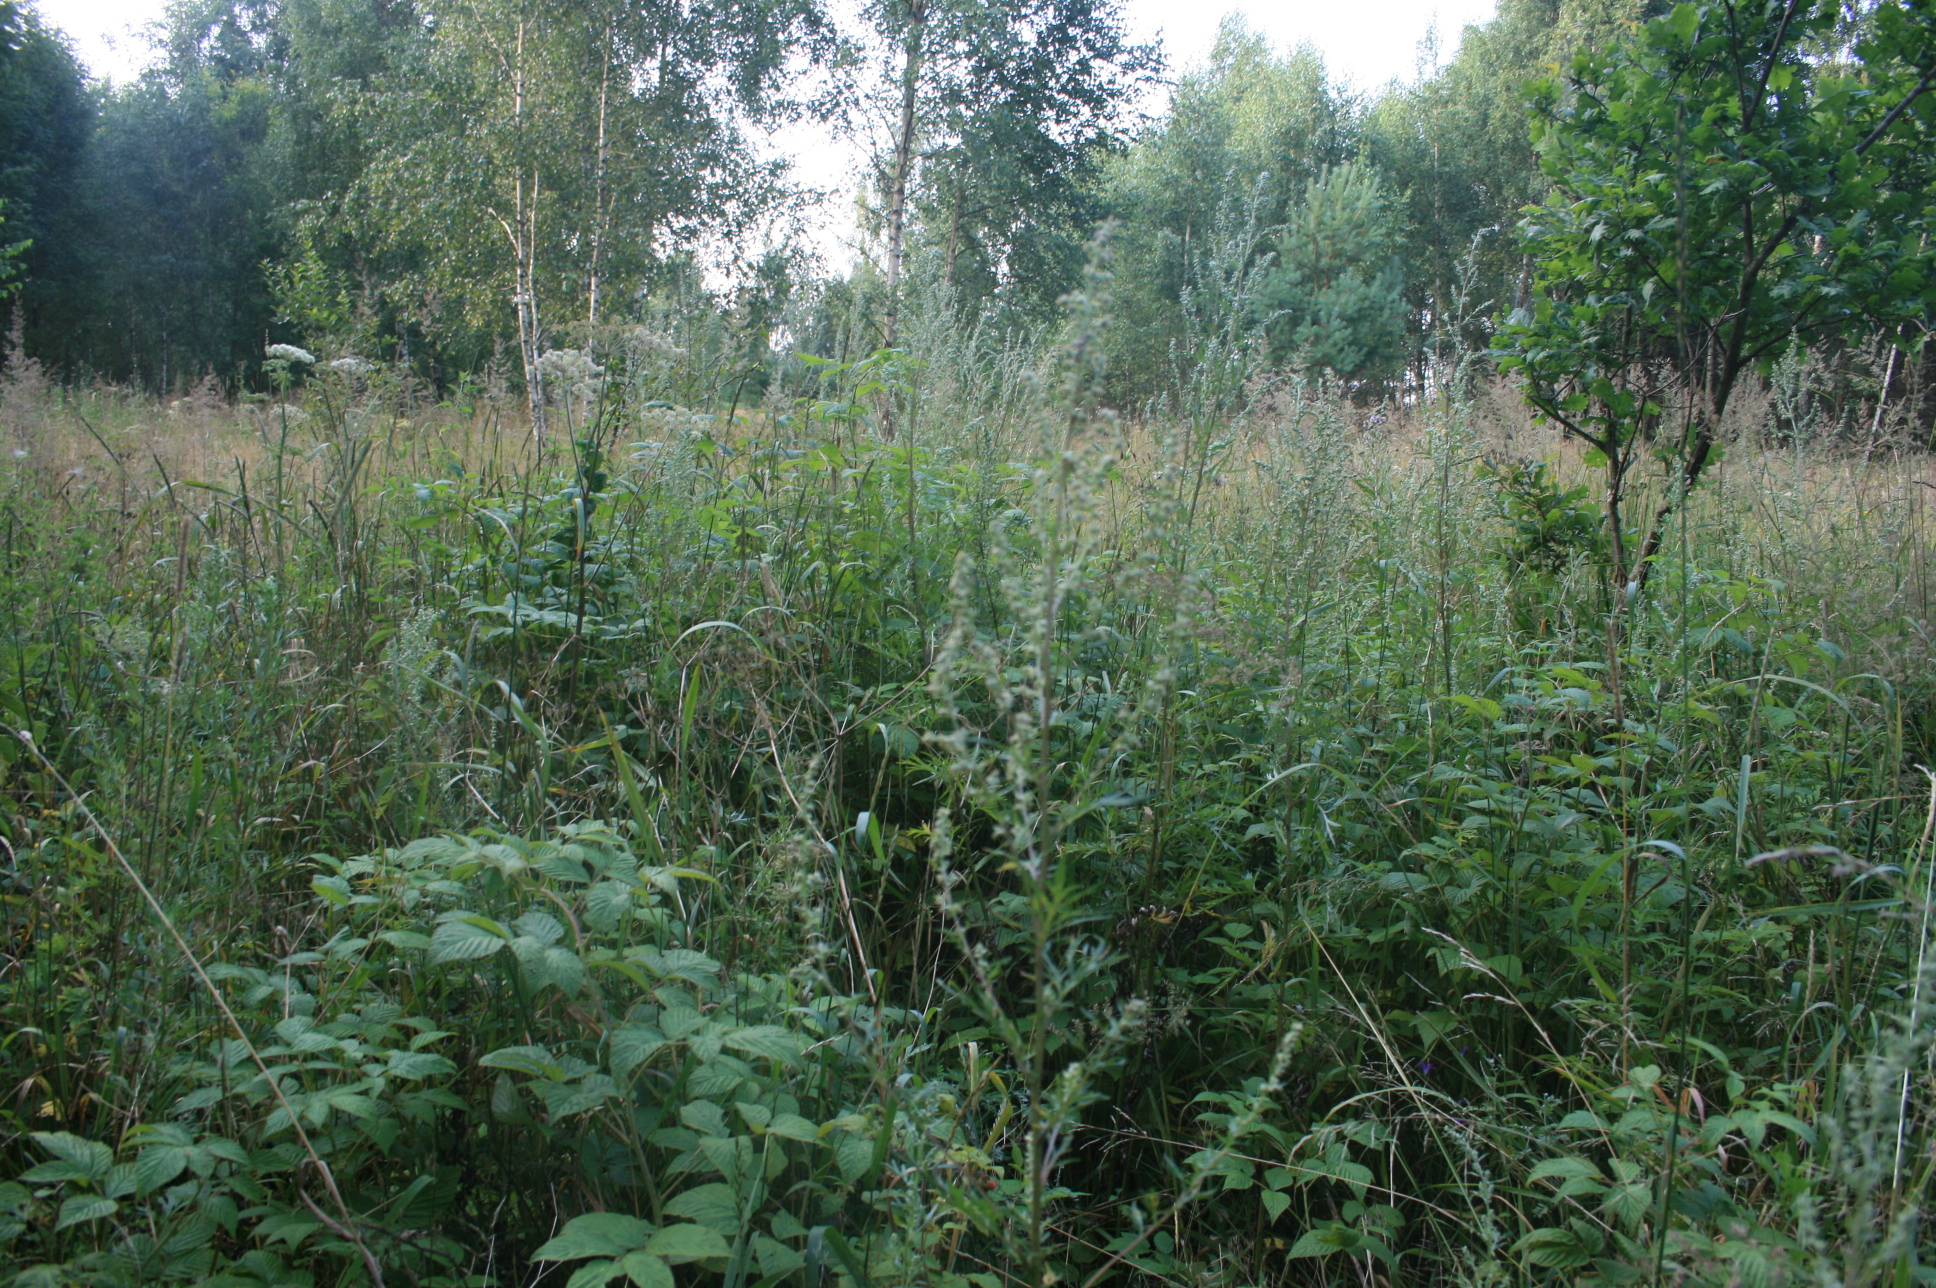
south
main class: Grassland
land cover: Spontaneously vegetated surfaces
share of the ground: > 75 %
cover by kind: herbaceous plants 100 %
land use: Semi-natural and natural areas not in use
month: August
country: LT
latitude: 55.6417
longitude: 21.5972
